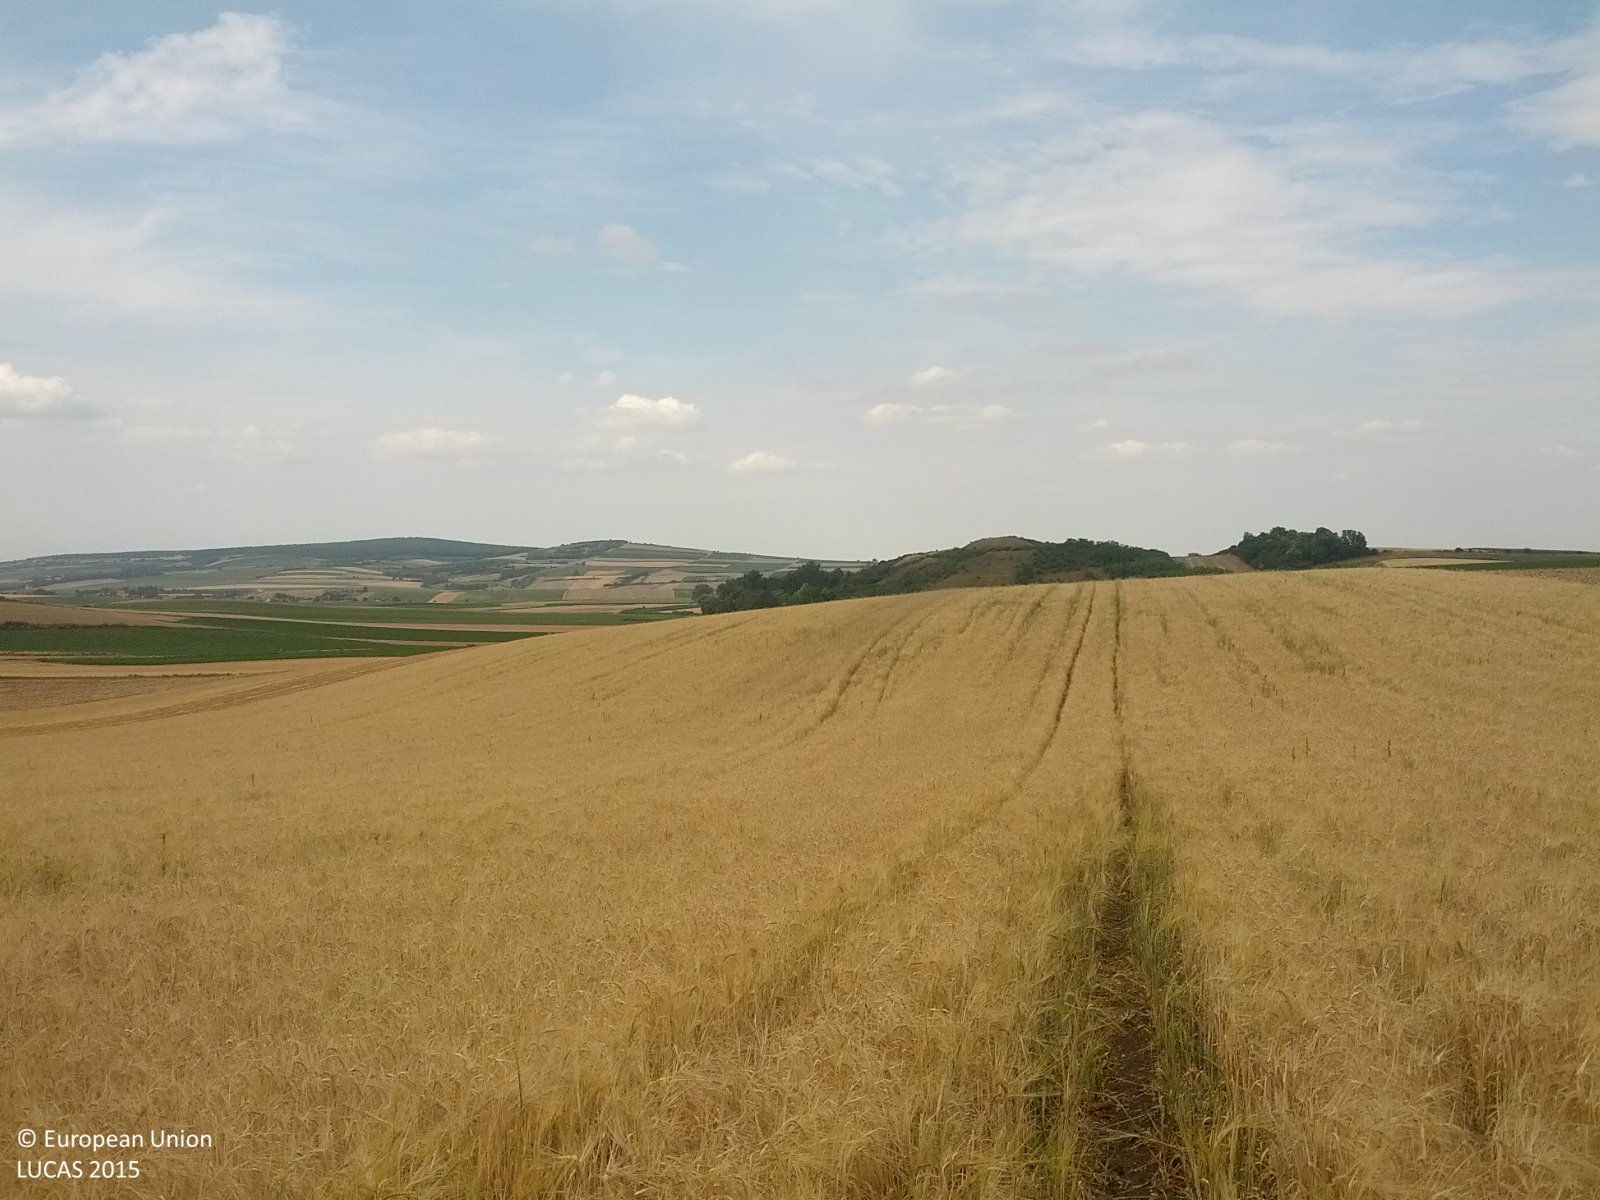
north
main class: Cropland
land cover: Barley
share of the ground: > 75 %
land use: Agriculture (excluding fallow land and kitchen gardens)
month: July
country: AT
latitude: 48.6098
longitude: 16.1762
